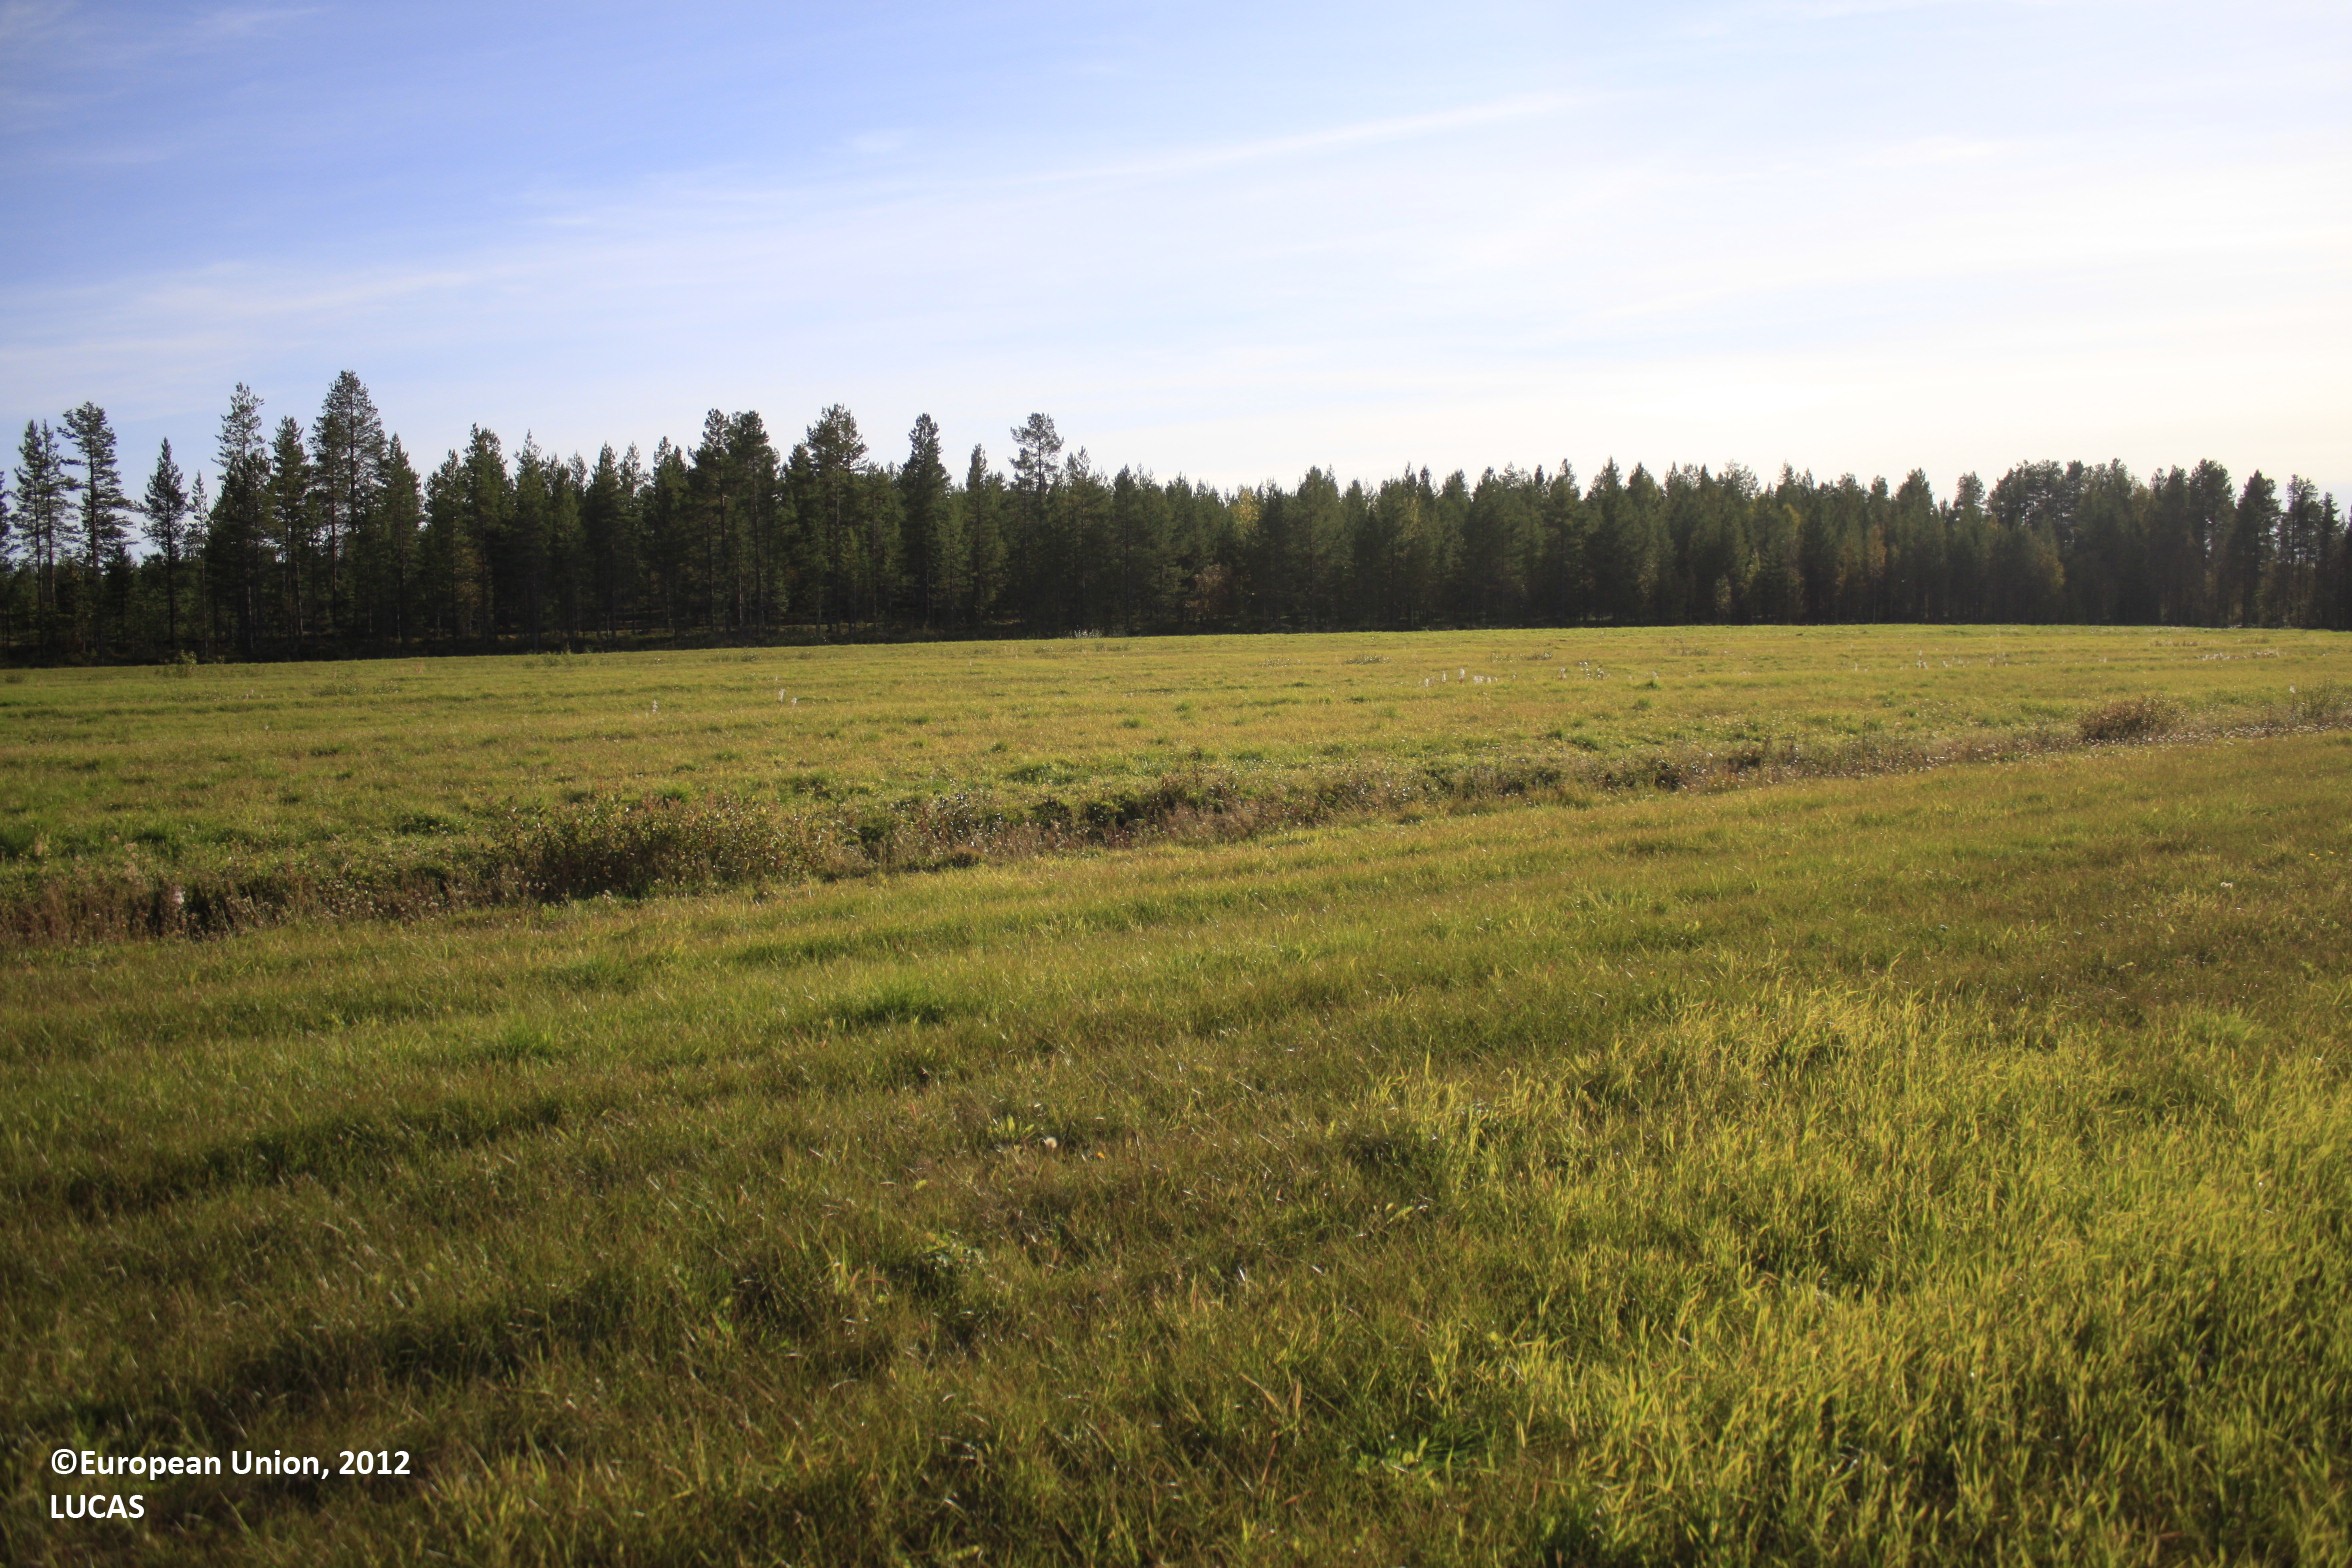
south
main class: Grassland
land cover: Grassland without tree/shrub cover
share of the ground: > 75 %
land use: Fallow land
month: September
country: FI
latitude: 65.8548
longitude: 26.7763
